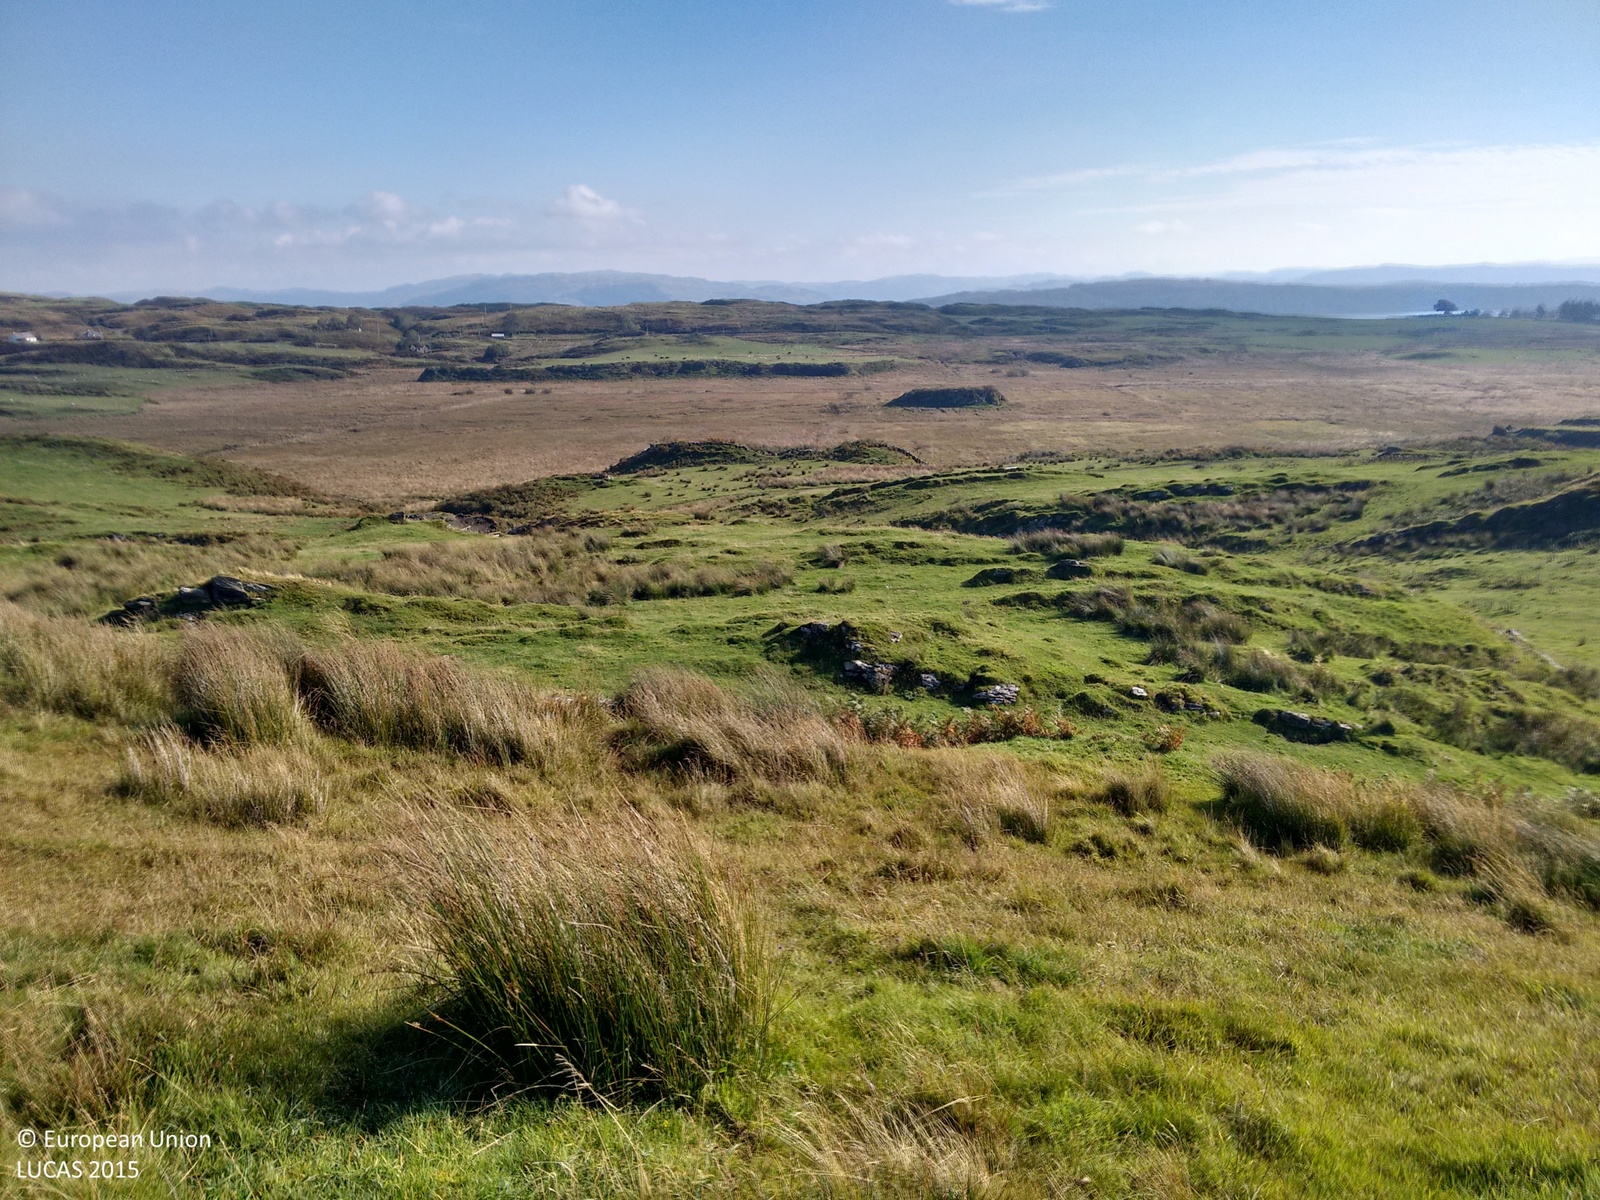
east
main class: Grassland
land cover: Grassland without tree/shrub cover
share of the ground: > 75 %
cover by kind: herbaceous plants 95 %, shrubs 5 %
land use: Agriculture (excluding fallow land and kitchen gardens)
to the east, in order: Grassland without tree/shrub cover; Tracks; Grassland without tree/shrub cover; Shrubland without tree cover
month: September
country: GB
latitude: 56.2274
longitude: -5.6584
